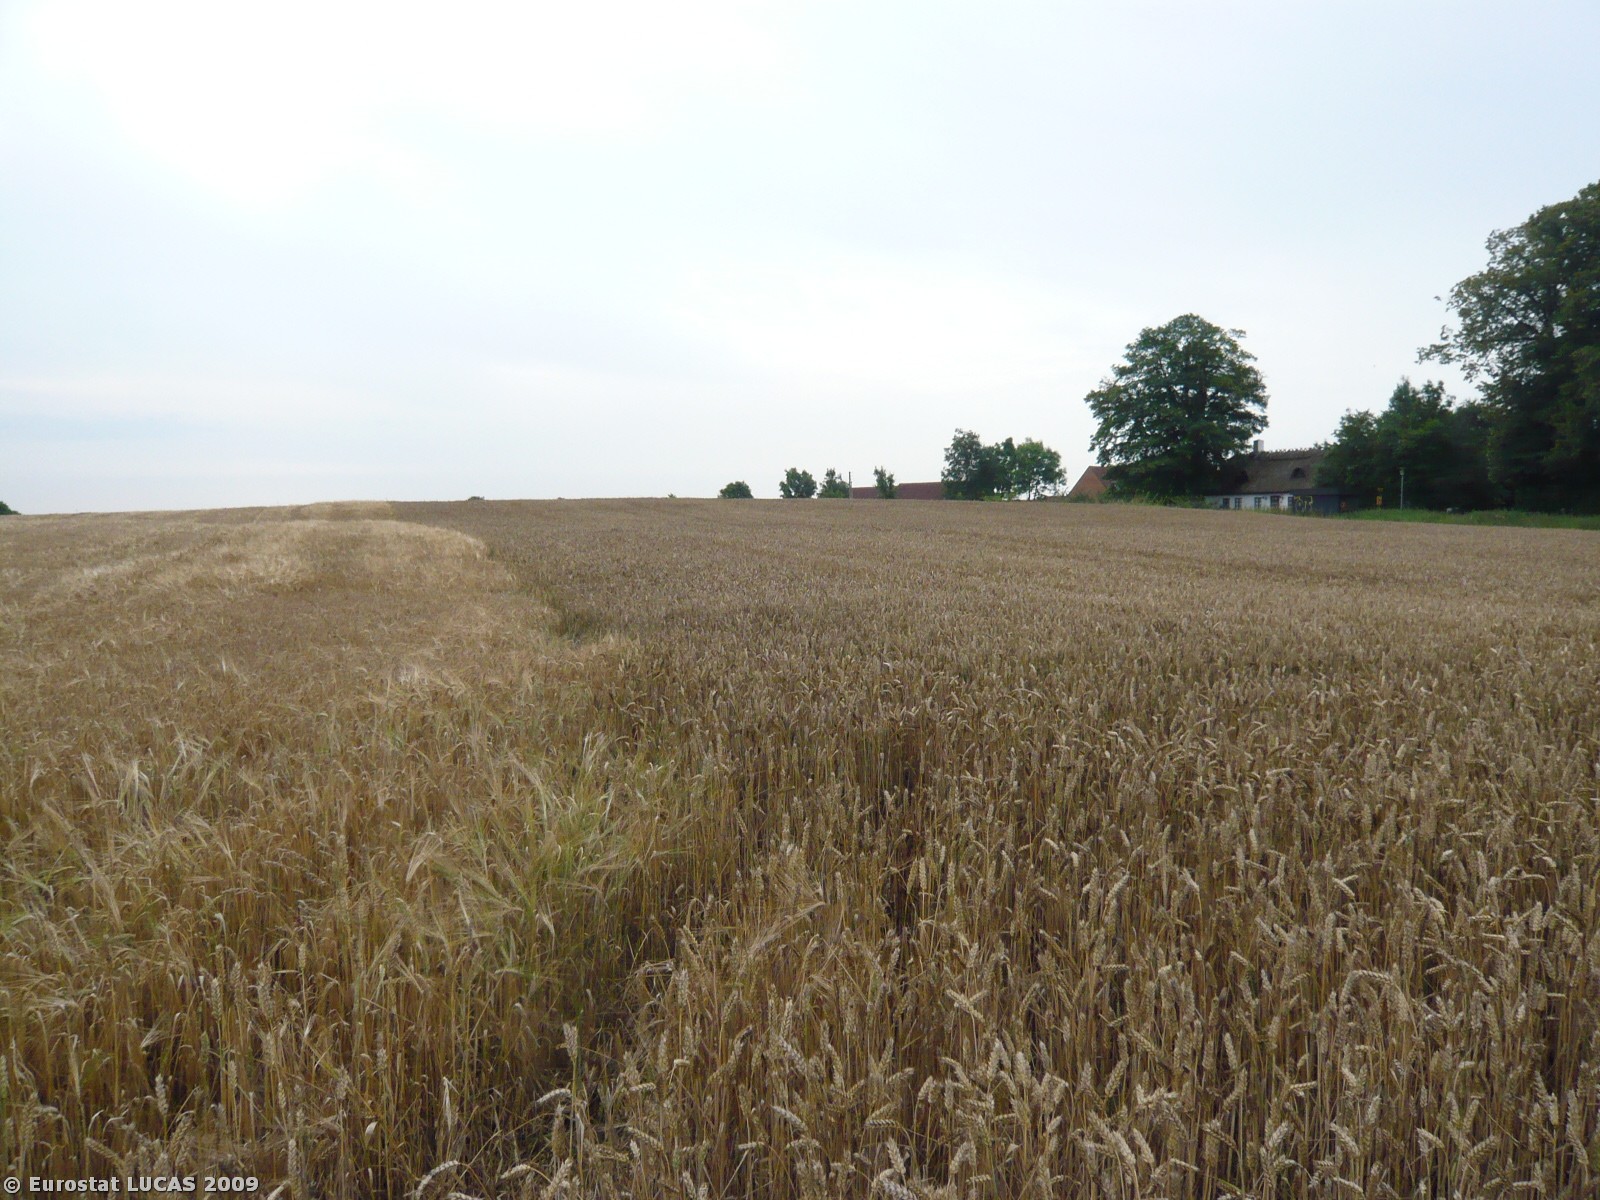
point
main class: Cropland
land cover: Common wheat
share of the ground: > 75 %
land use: Agriculture (excluding fallow land and kitchen gardens)
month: July
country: DK
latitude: 55.7545
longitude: 12.2447
